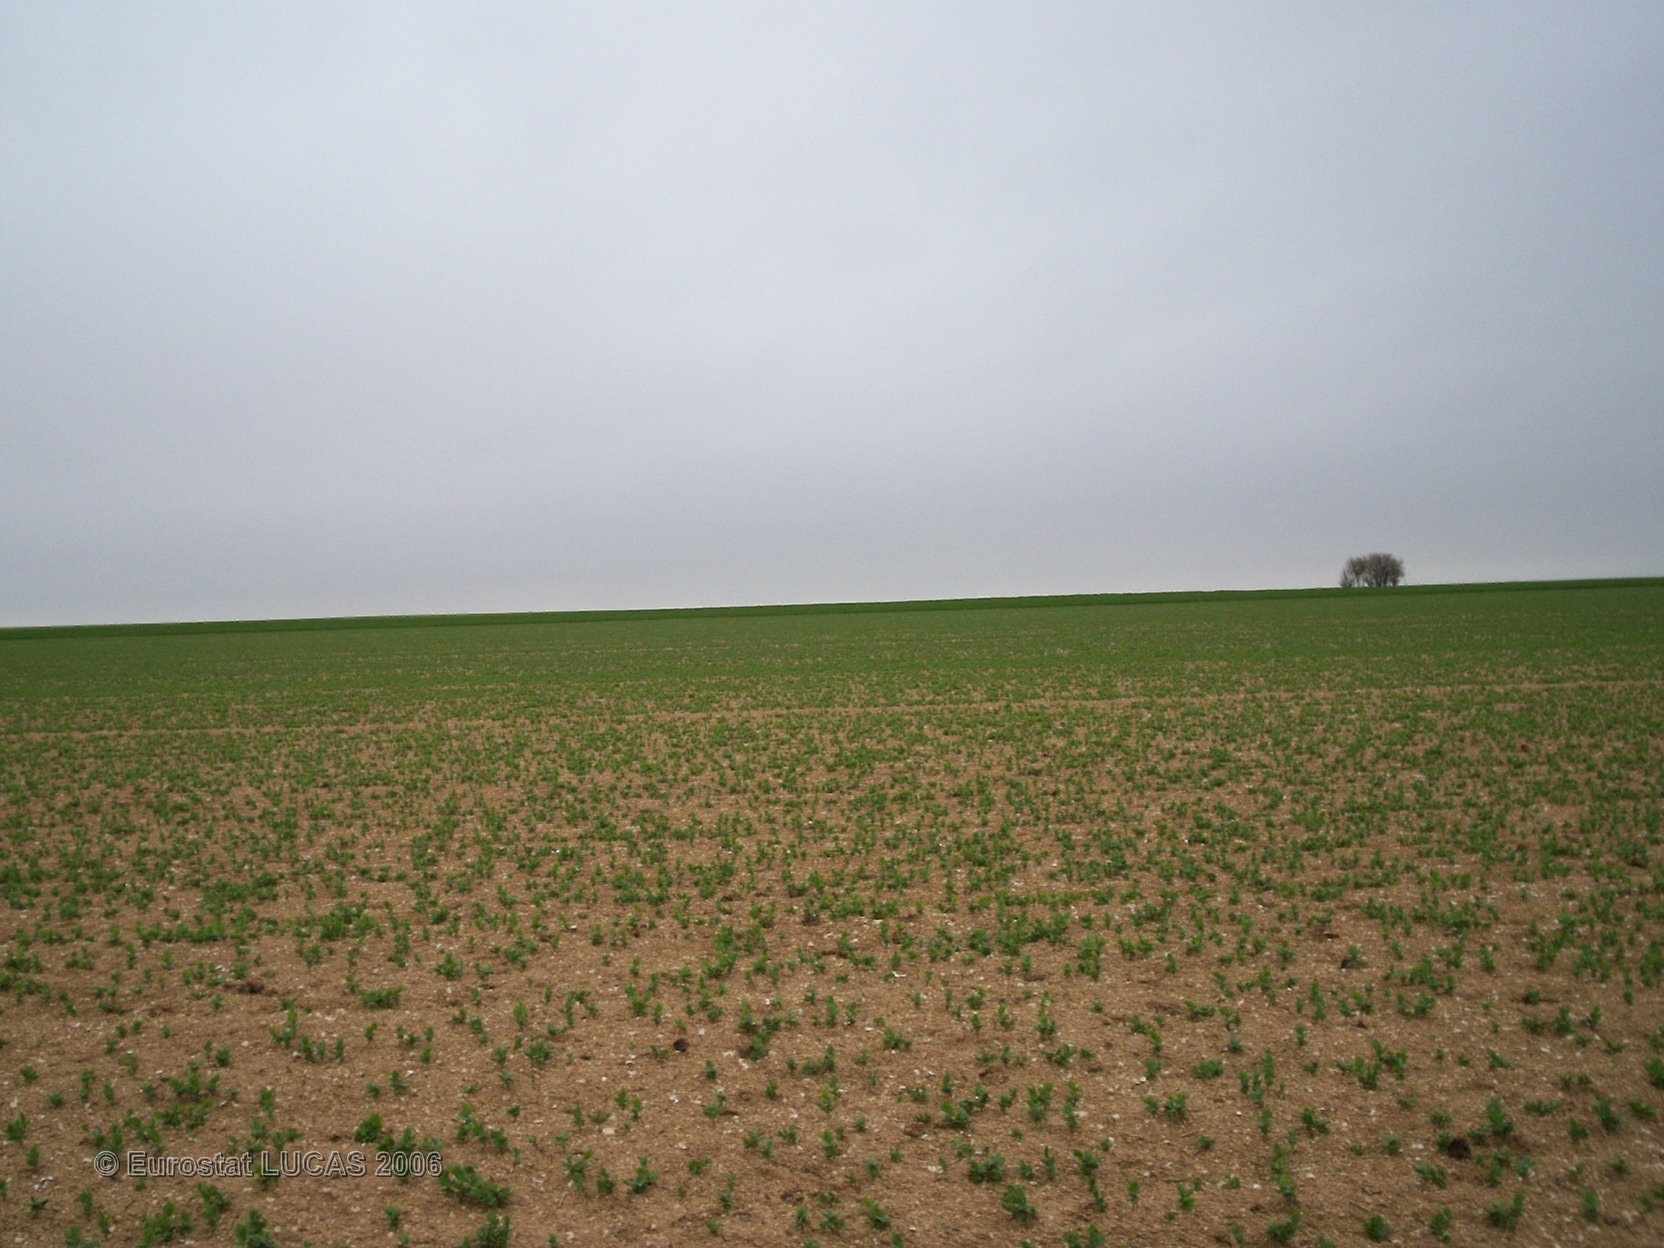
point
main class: Cropland
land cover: Dry pulses
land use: Agriculture (excluding fallow land and kitchen gardens)
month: April
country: FR
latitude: 49.2523
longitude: 4.3770
